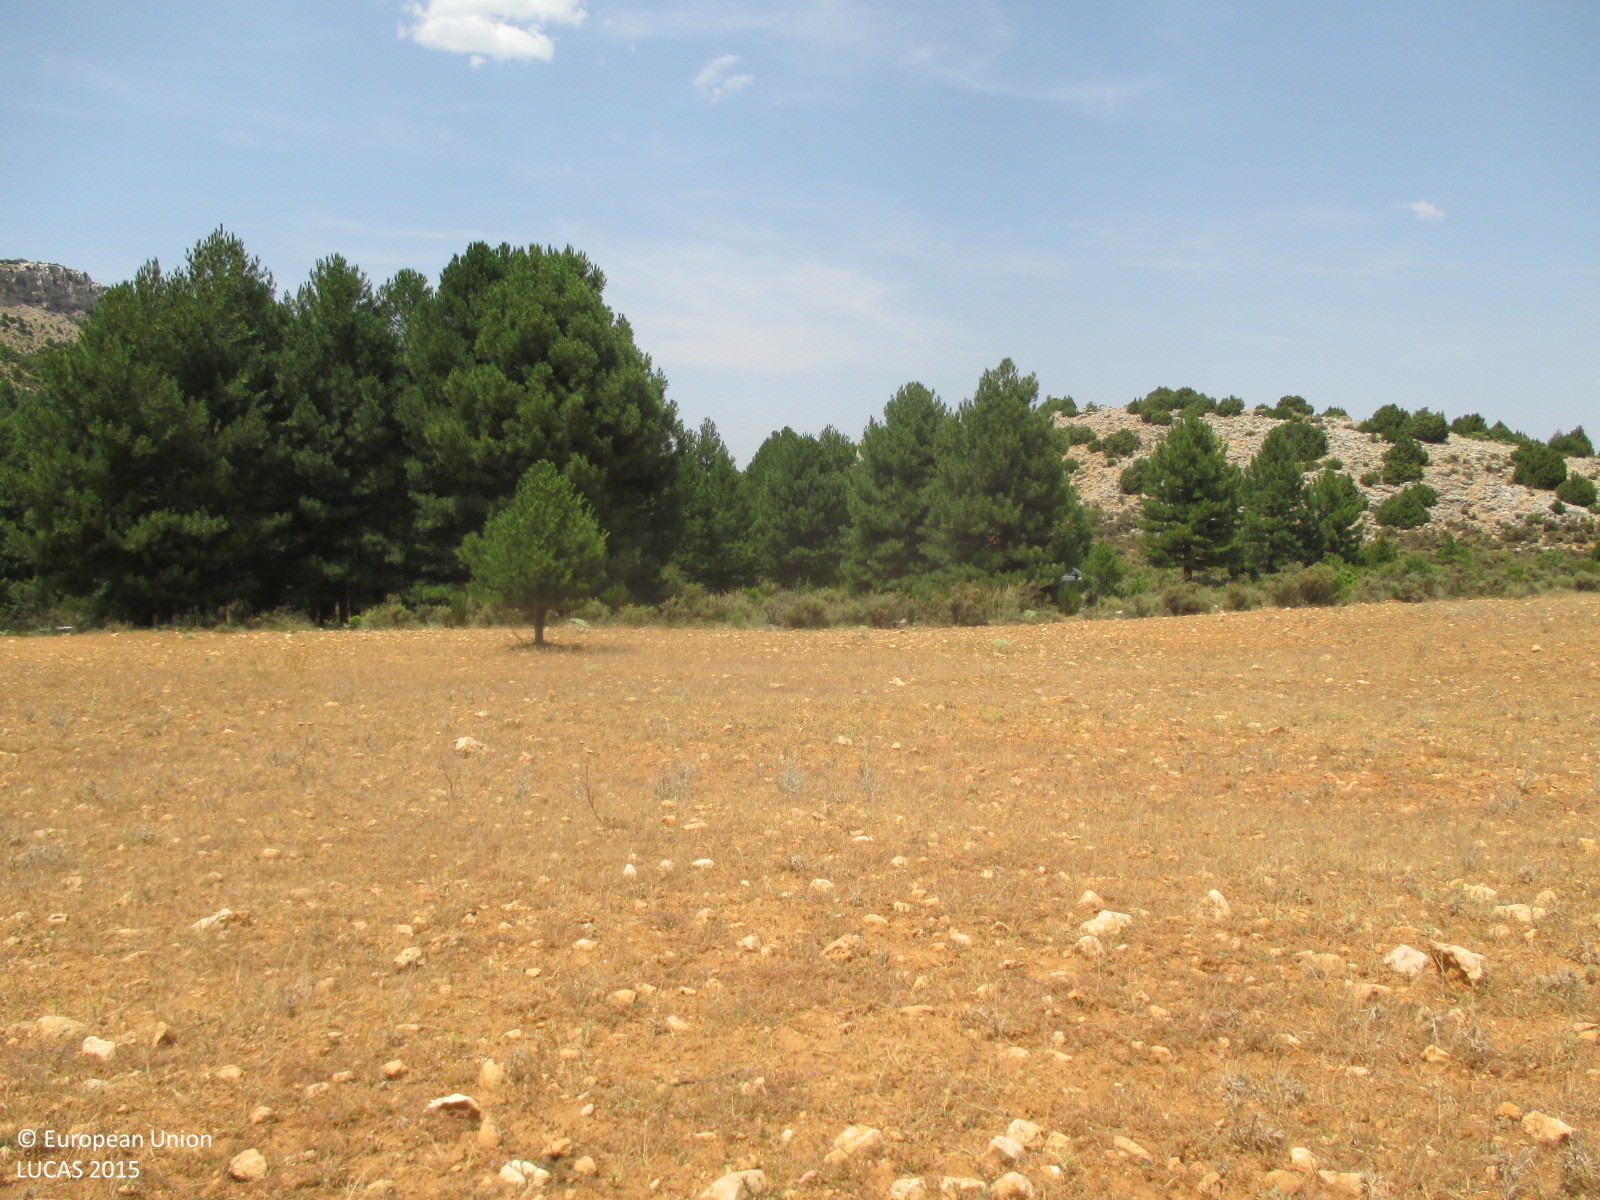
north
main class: Grassland
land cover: Grassland with sparse tree/shrub cover
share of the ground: > 75 %
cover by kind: herbaceous plants 90 %, coniferous forest trees 5 %, unconsolidated bare surface 5 %
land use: Agriculture (excluding fallow land and kitchen gardens)
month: July
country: ES
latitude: 38.1688
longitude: -2.3321
